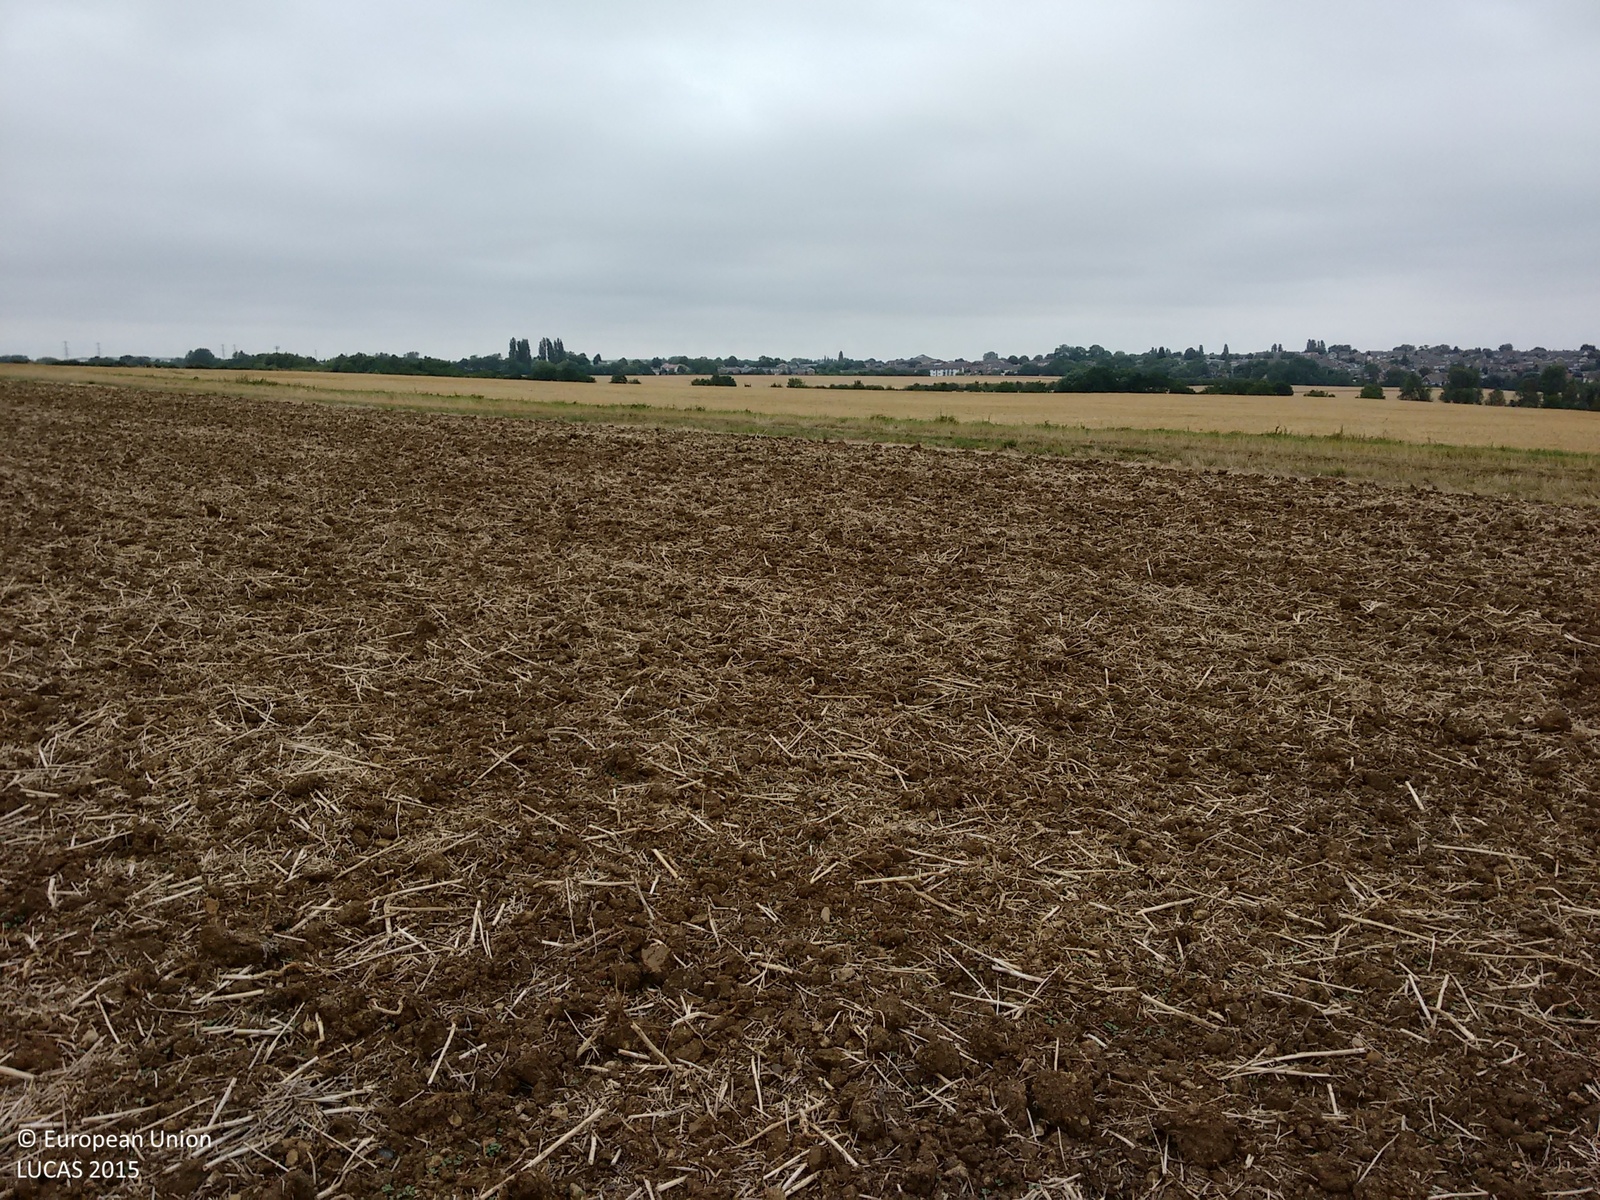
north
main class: Cropland
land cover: Rape and turnip rape
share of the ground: < 10 %
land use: Agriculture (excluding fallow land and kitchen gardens)
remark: Harvested field
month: August
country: GB
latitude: 52.2889
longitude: -0.7285
